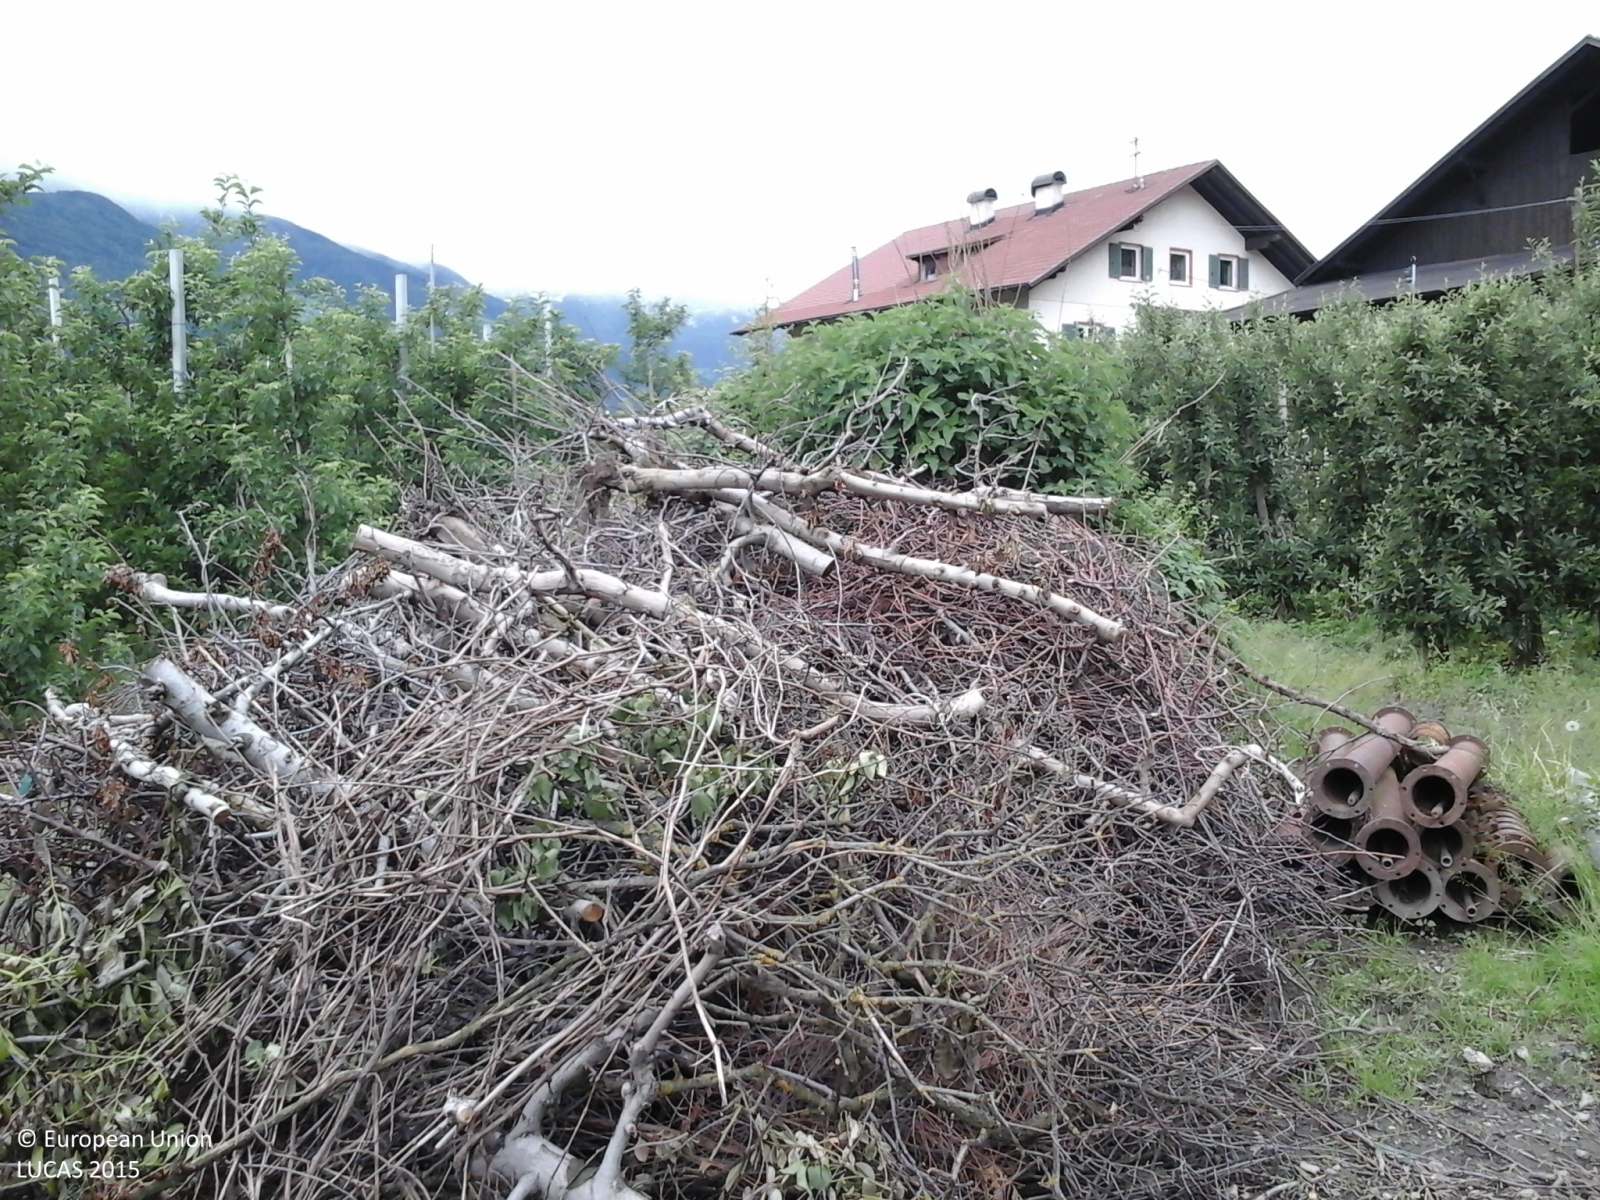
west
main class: Grassland
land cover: Grassland without tree/shrub cover
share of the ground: > 75 %
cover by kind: herbaceous plants 100 %
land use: Agriculture (excluding fallow land and kitchen gardens)
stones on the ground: < 10 %
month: May
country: IT
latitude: 46.6702
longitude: 11.0575
